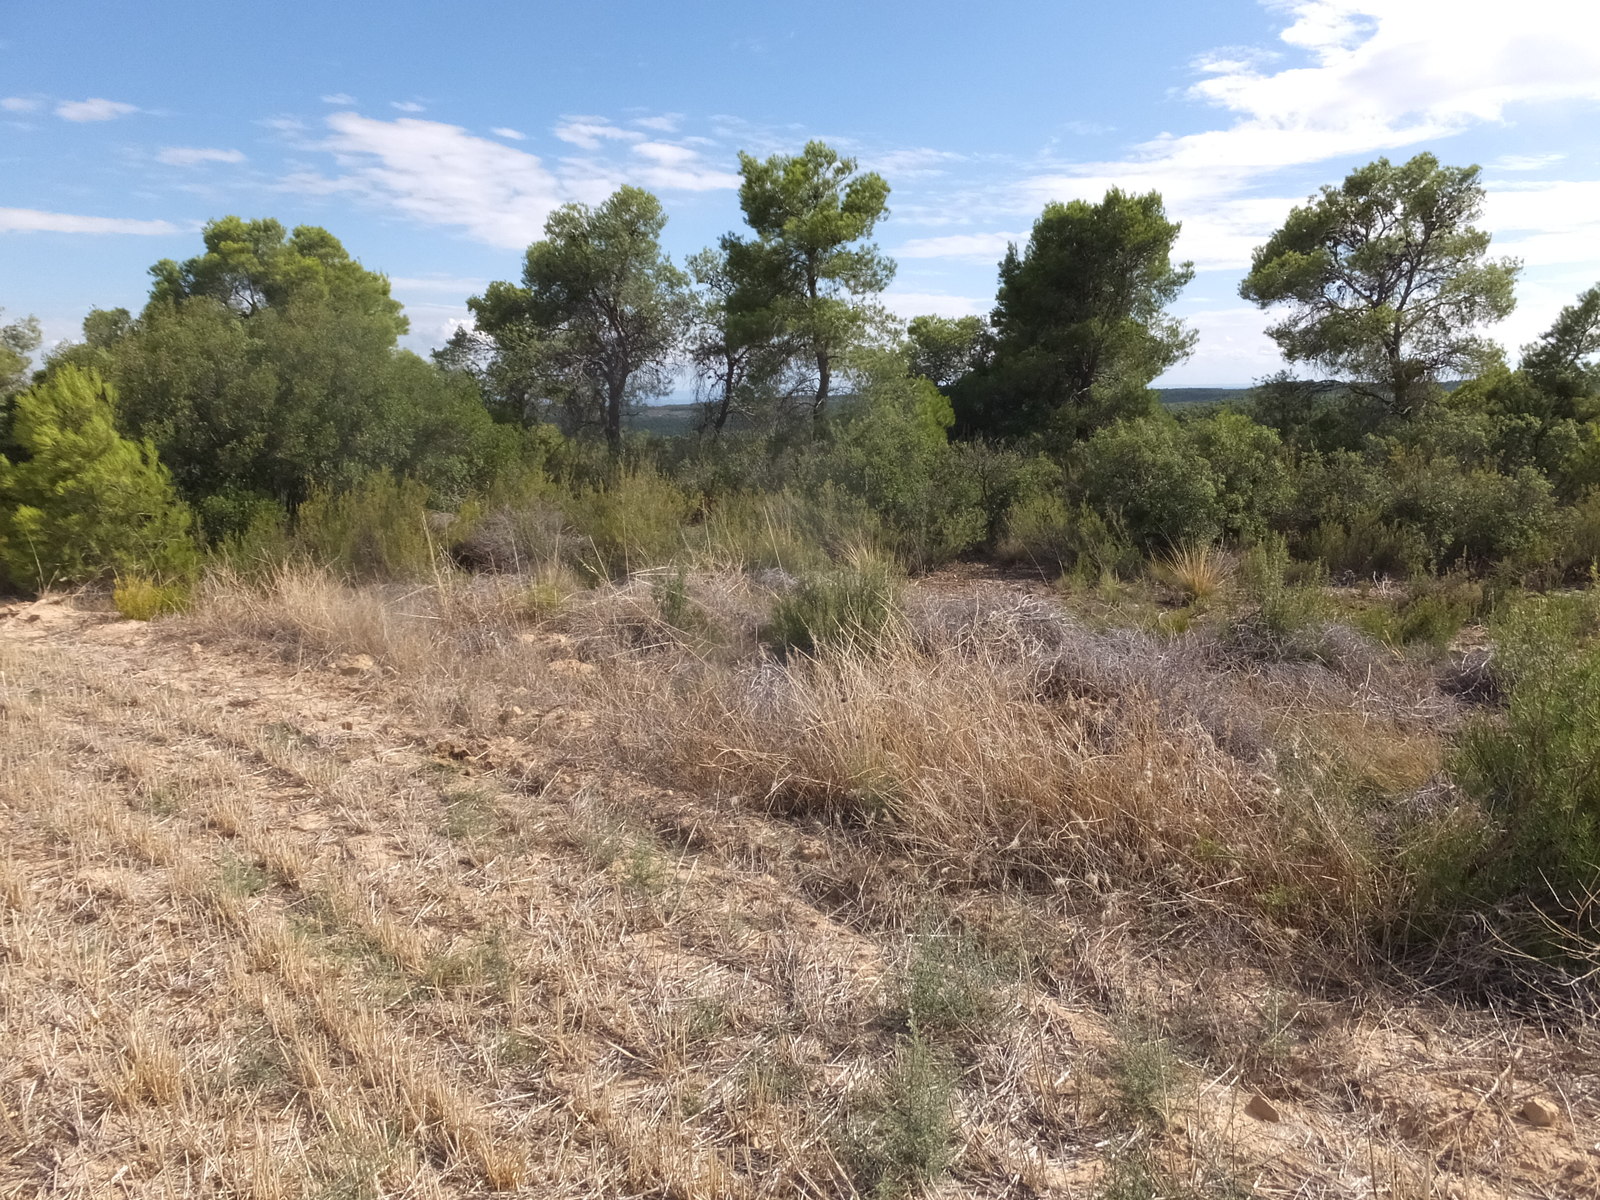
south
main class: Cropland
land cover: Barley
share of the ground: < 10 %
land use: Agriculture (excluding fallow land and kitchen gardens)
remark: Harvested field
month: August
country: ES
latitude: 41.2874
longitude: 0.2091
